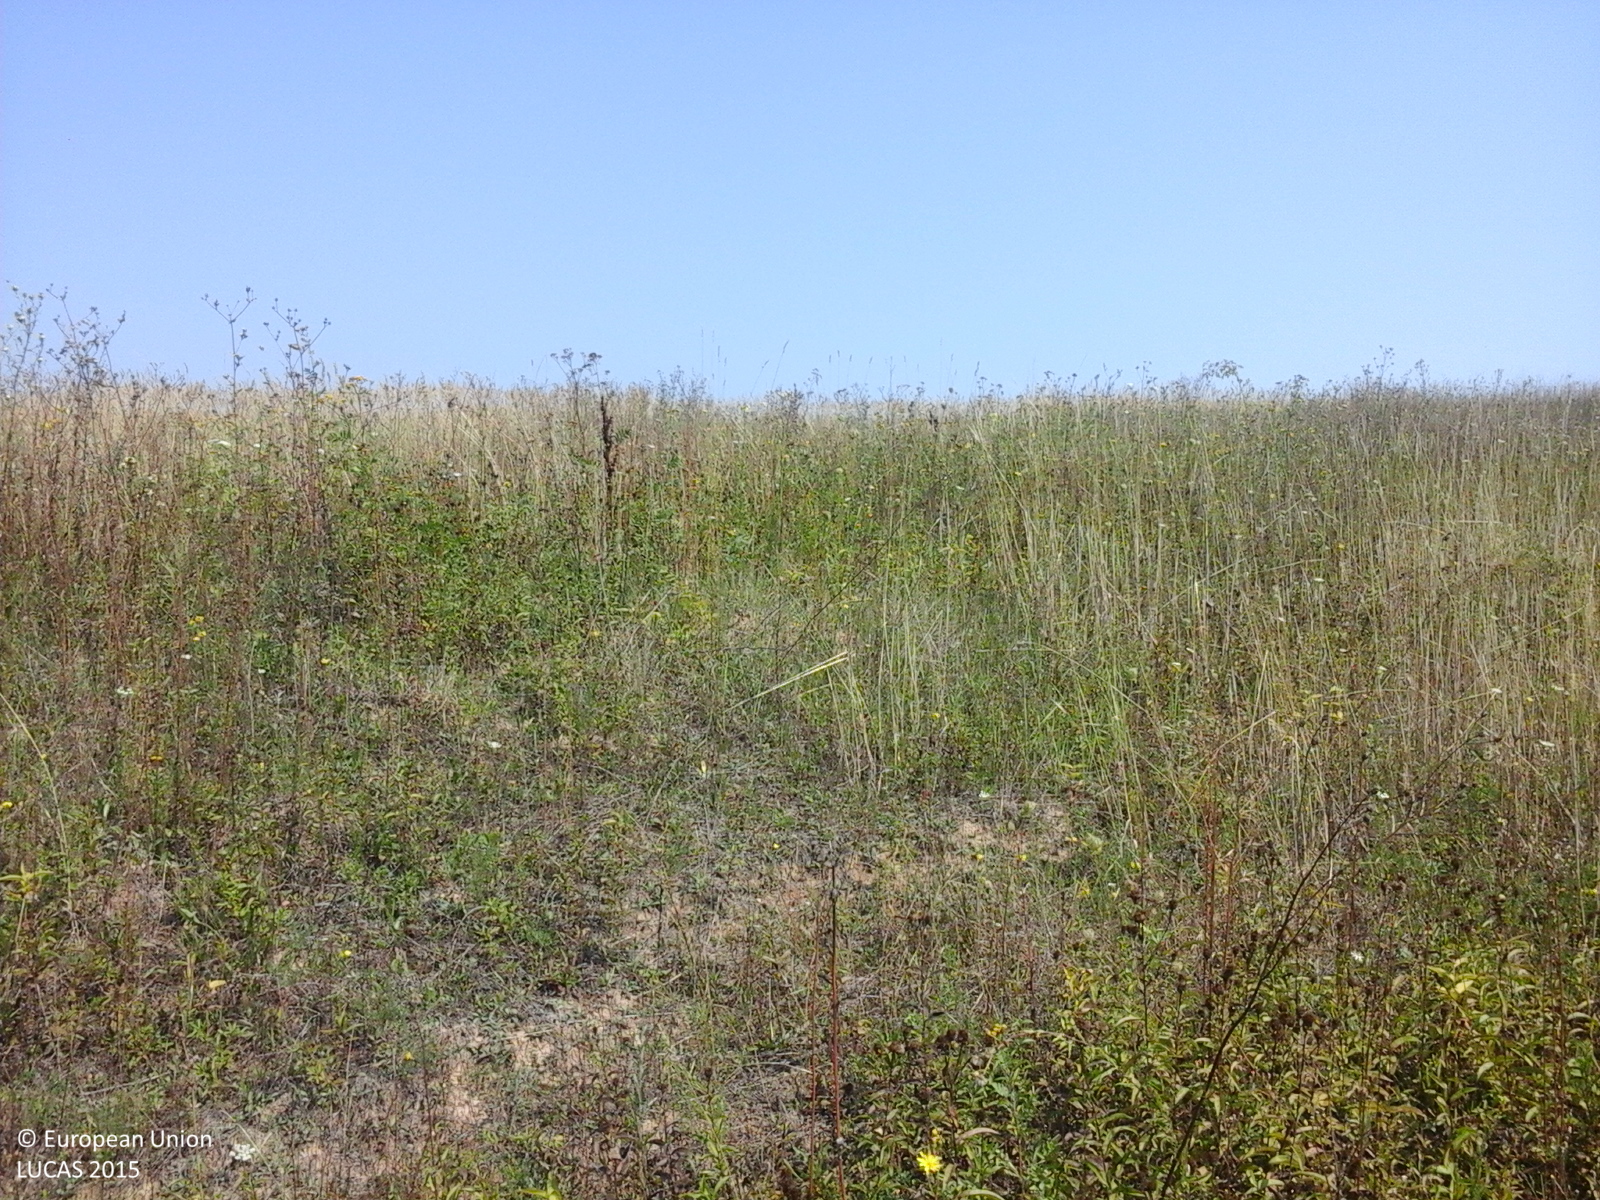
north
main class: Grassland
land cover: Grassland without tree/shrub cover
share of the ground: > 75 %
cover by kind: herbaceous plants 100 %
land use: Agriculture (excluding fallow land and kitchen gardens)
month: August
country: RO
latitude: 46.3069
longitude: 22.3443
